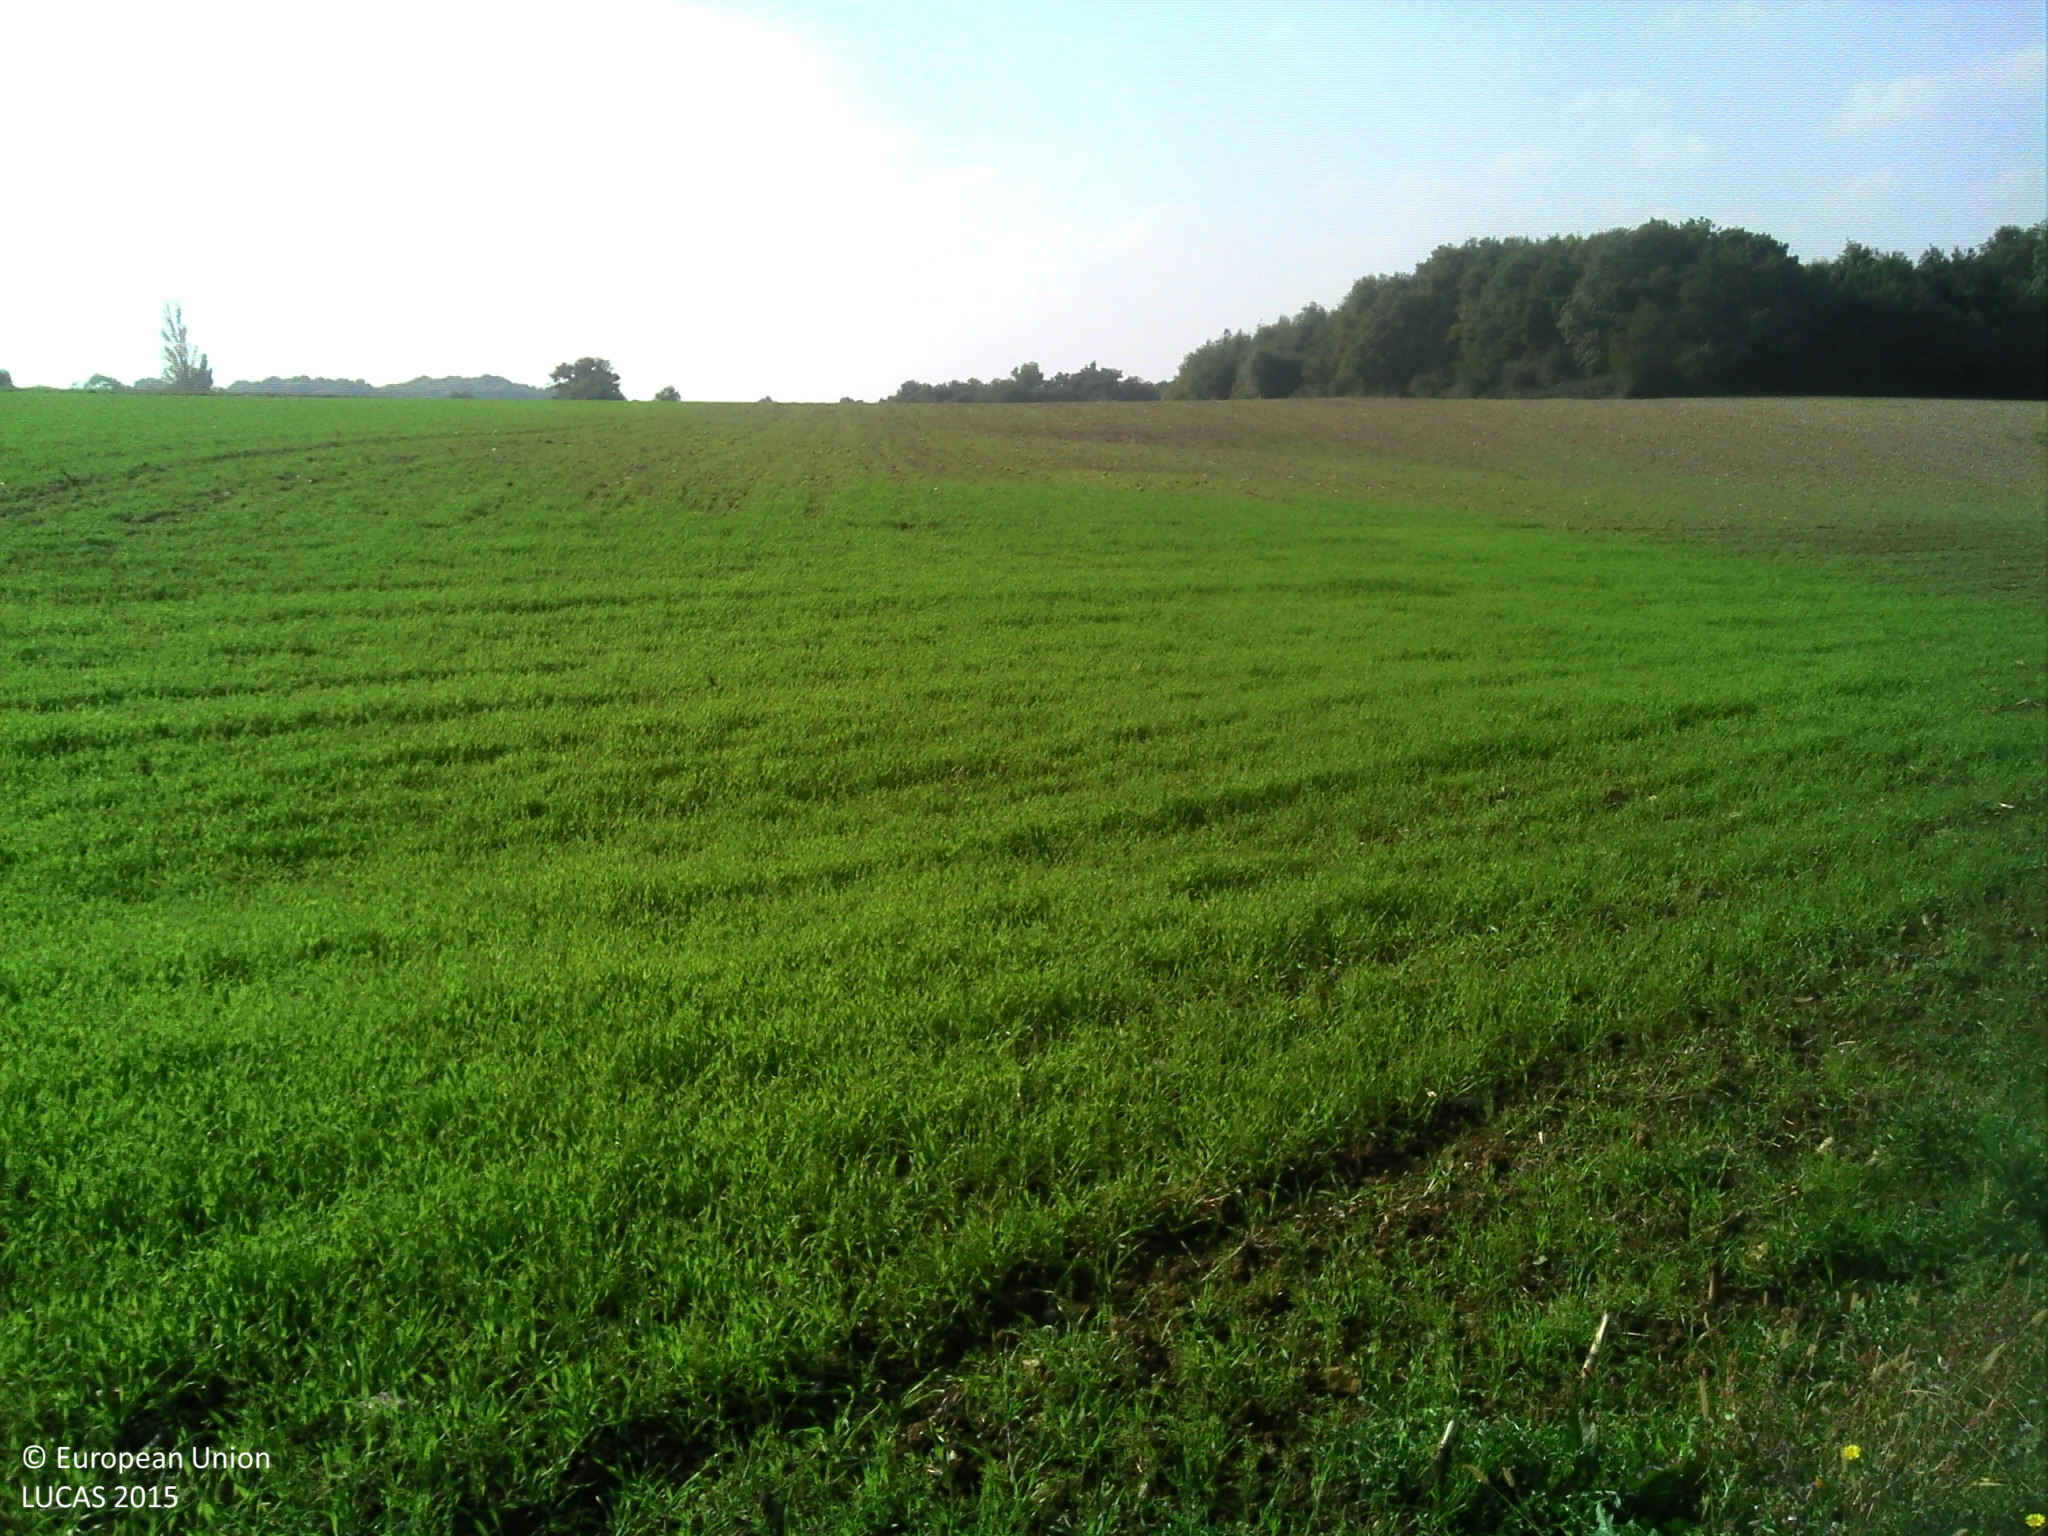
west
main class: Grassland
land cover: Grassland without tree/shrub cover
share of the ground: > 75 %
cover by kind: herbaceous plants 100 %
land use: Agriculture (excluding fallow land and kitchen gardens)
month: October
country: FR
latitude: 46.5077
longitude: -0.8337
